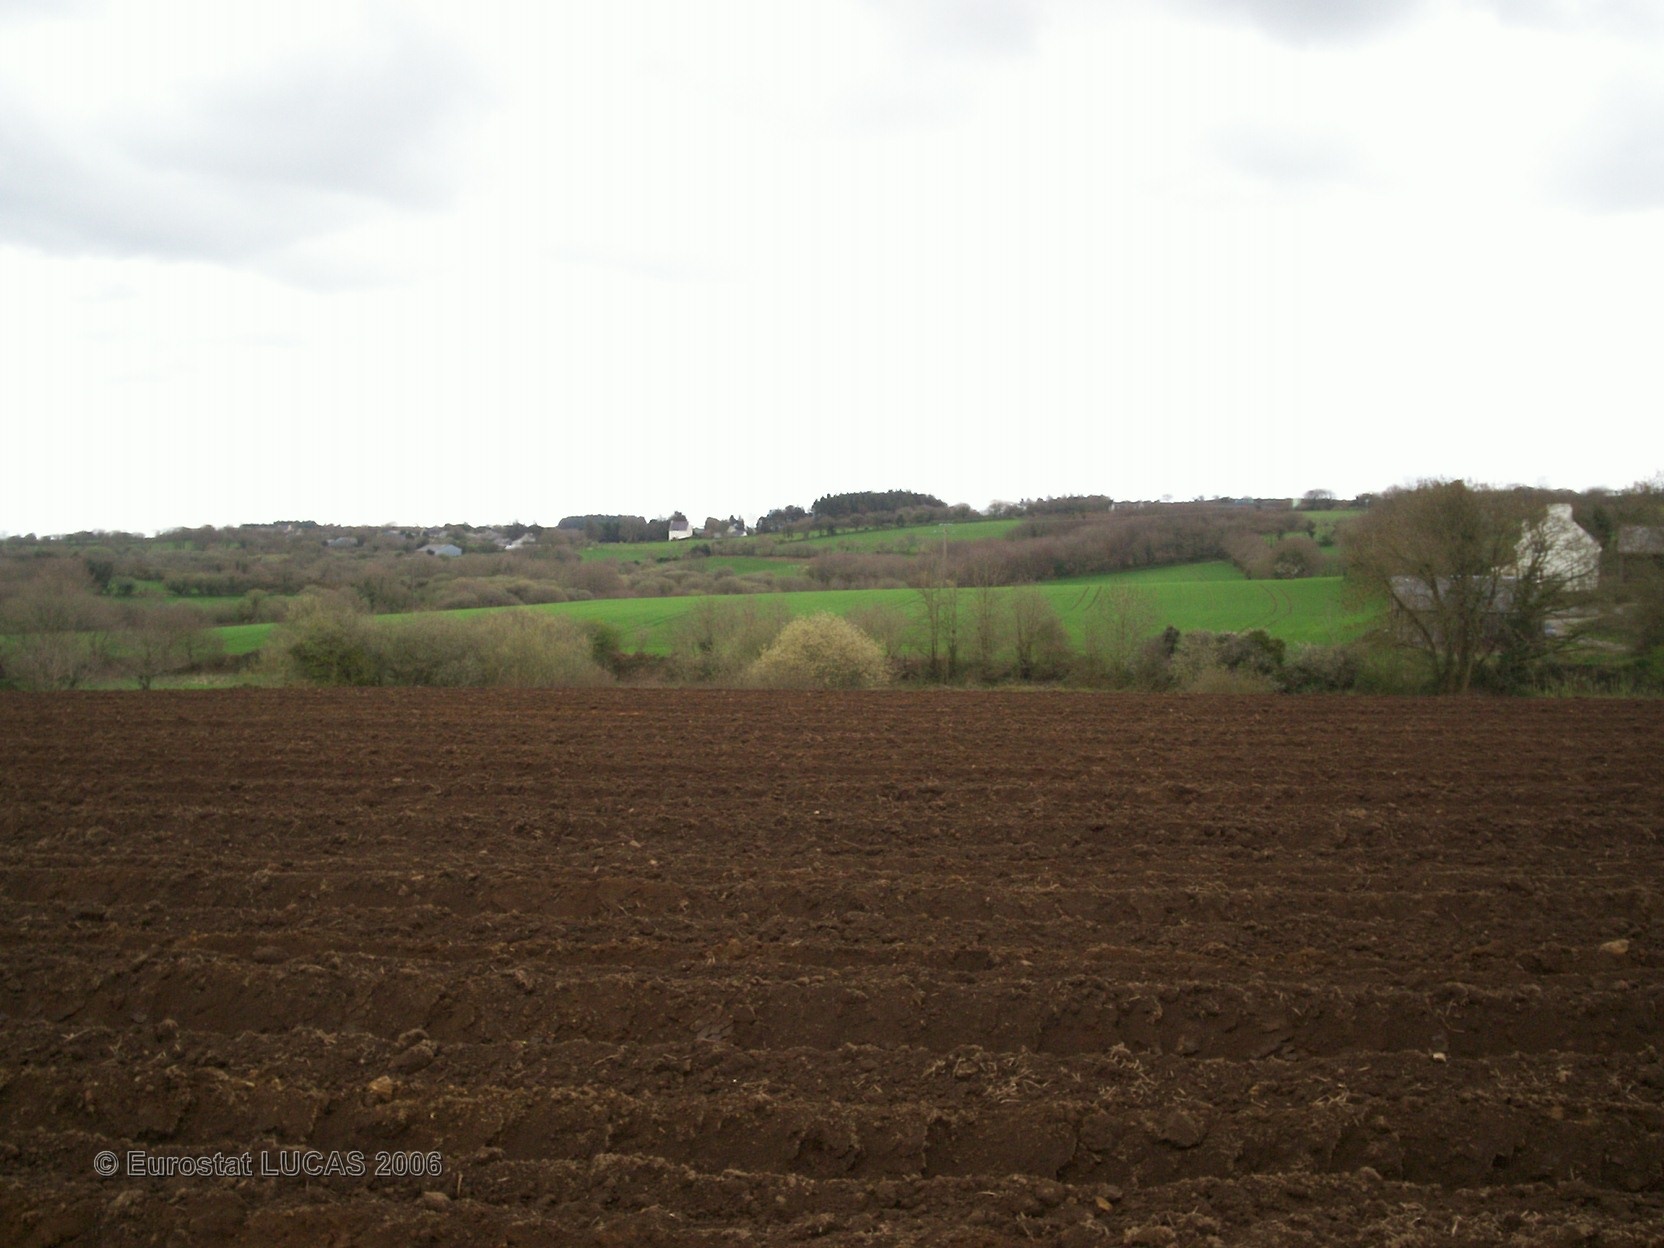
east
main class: Cropland
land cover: Potatoes
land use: Agriculture (excluding fallow land and kitchen gardens)
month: June
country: FR
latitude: 48.4211
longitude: -3.9928
